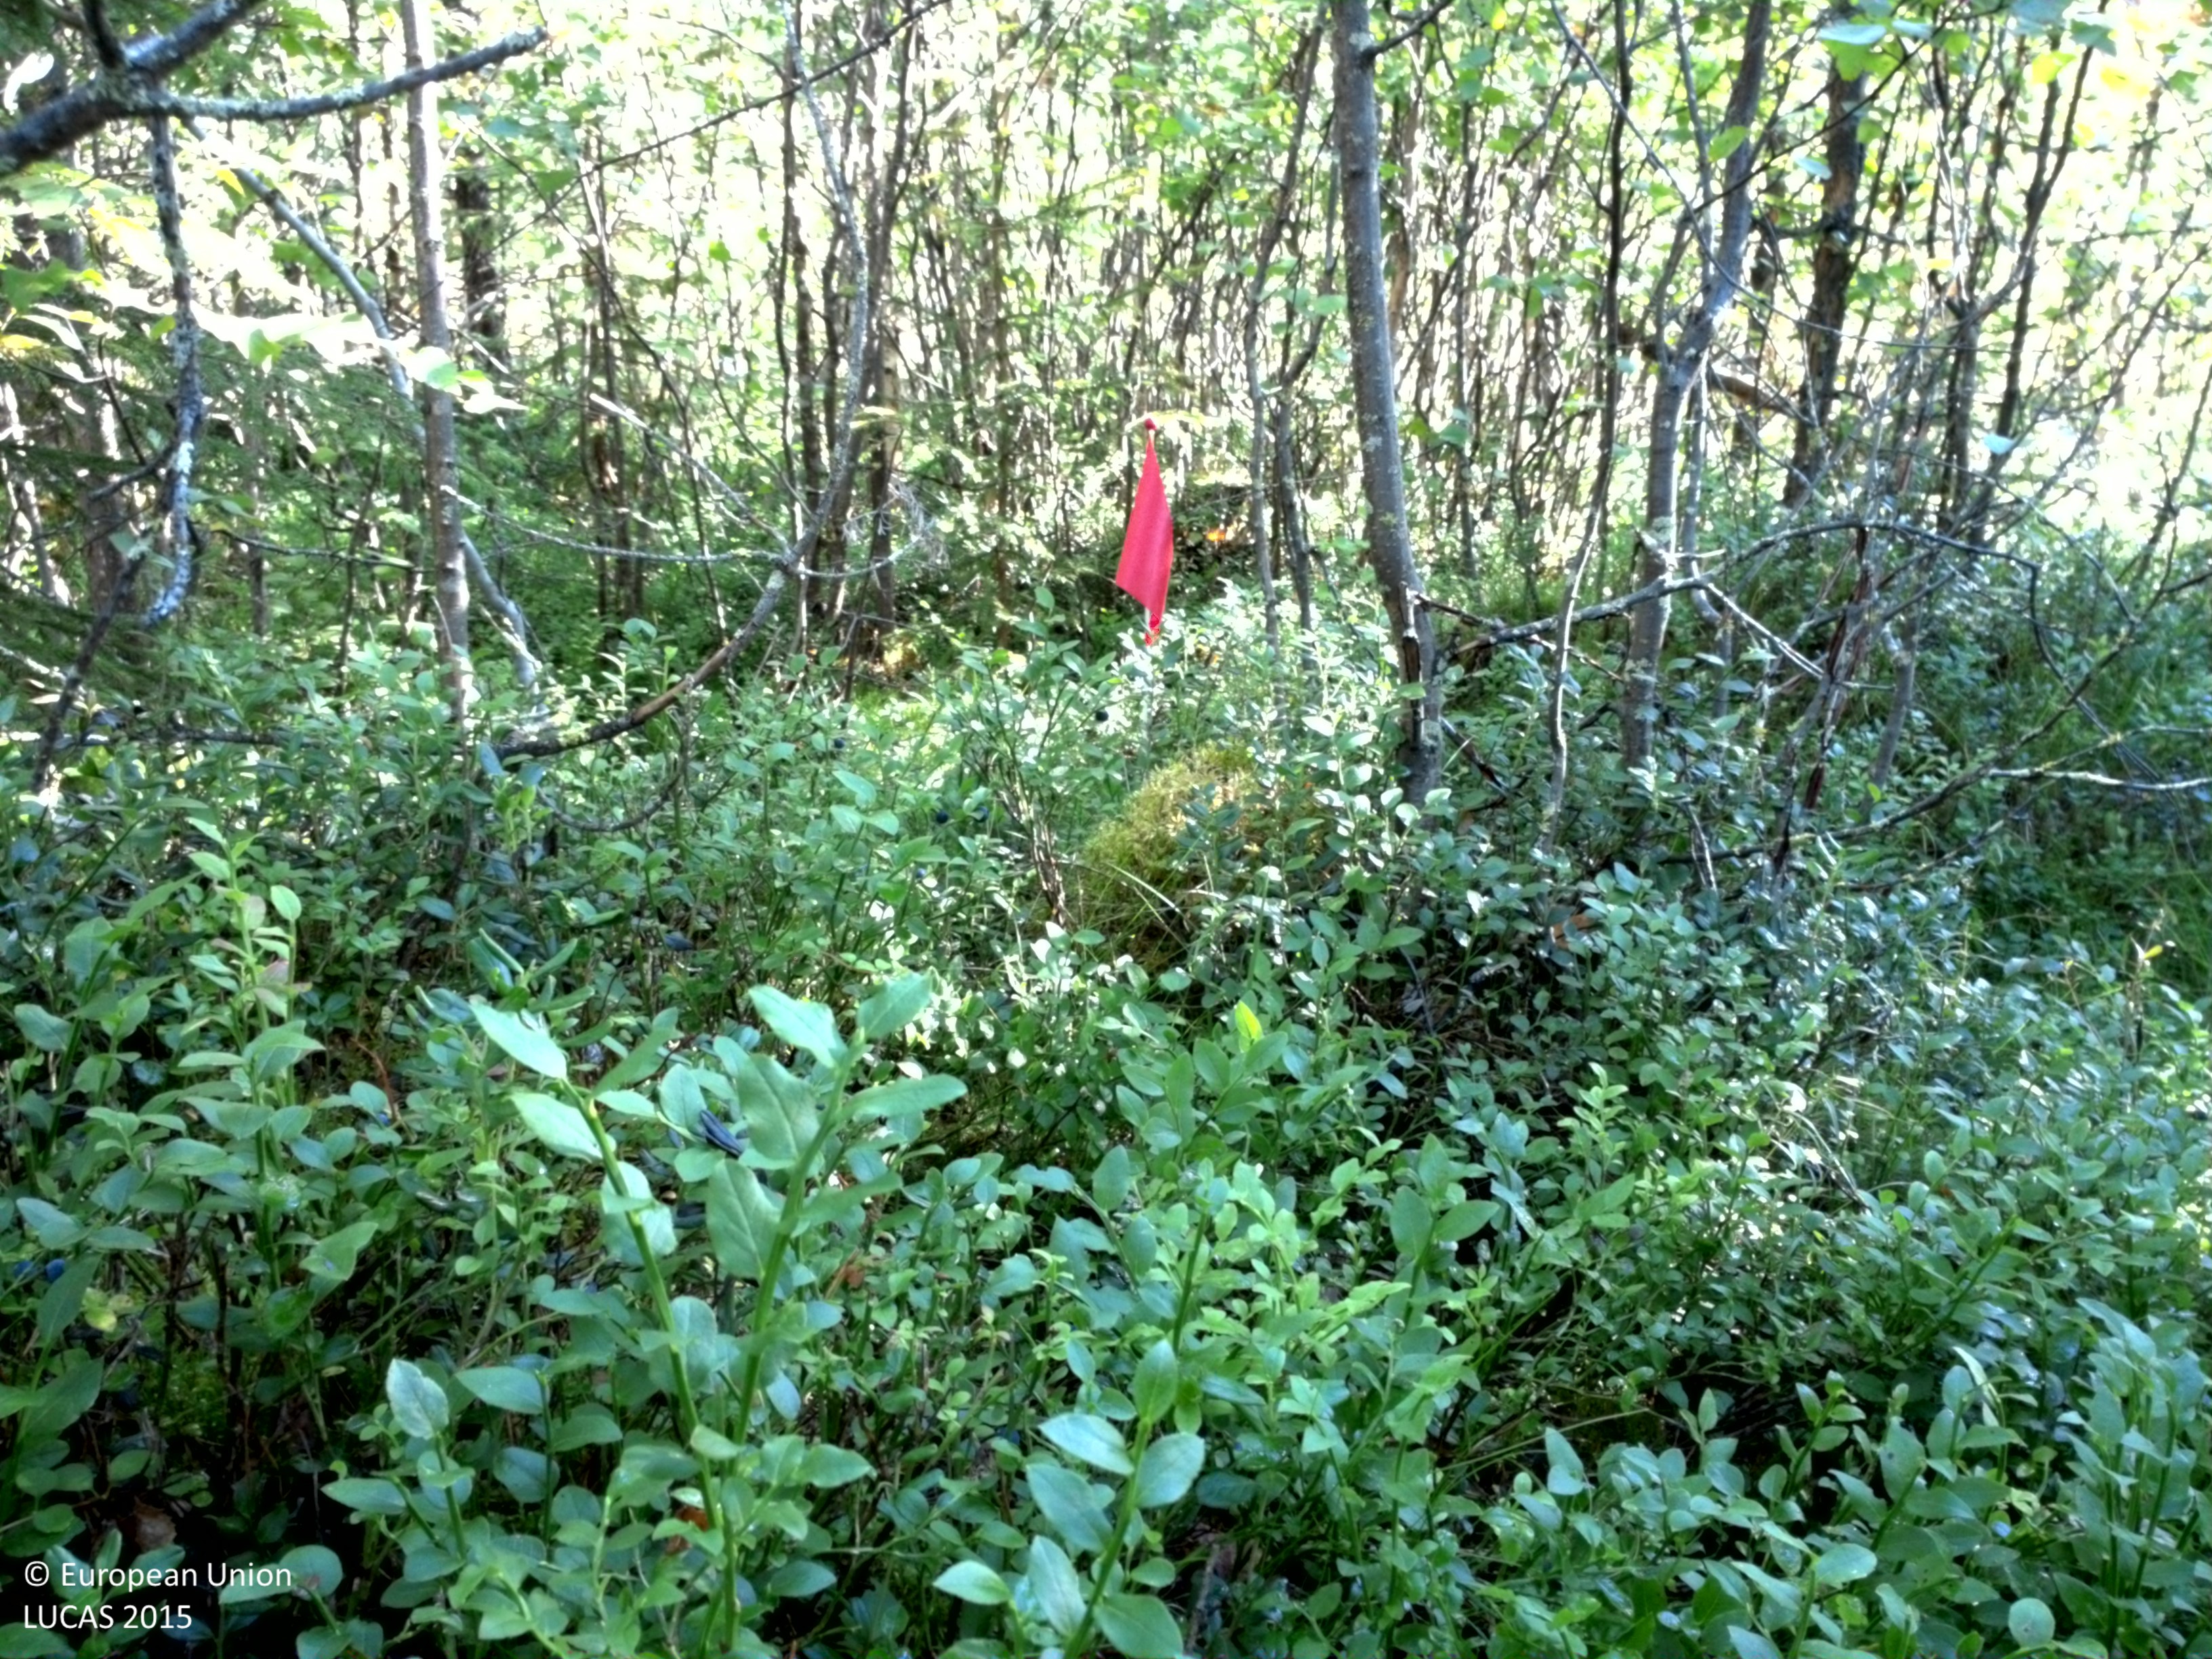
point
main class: Woodland
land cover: Pine dominated mixed woodland
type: boreal forest
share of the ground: 50 - 75 %
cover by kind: broadleaved forest trees 35 %, coniferous forest trees 30 %, shrubs 30 %, lichens and mosses 5 %
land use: Forestry
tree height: > 5 m
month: August
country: SE
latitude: 66.0636
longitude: 22.5462
